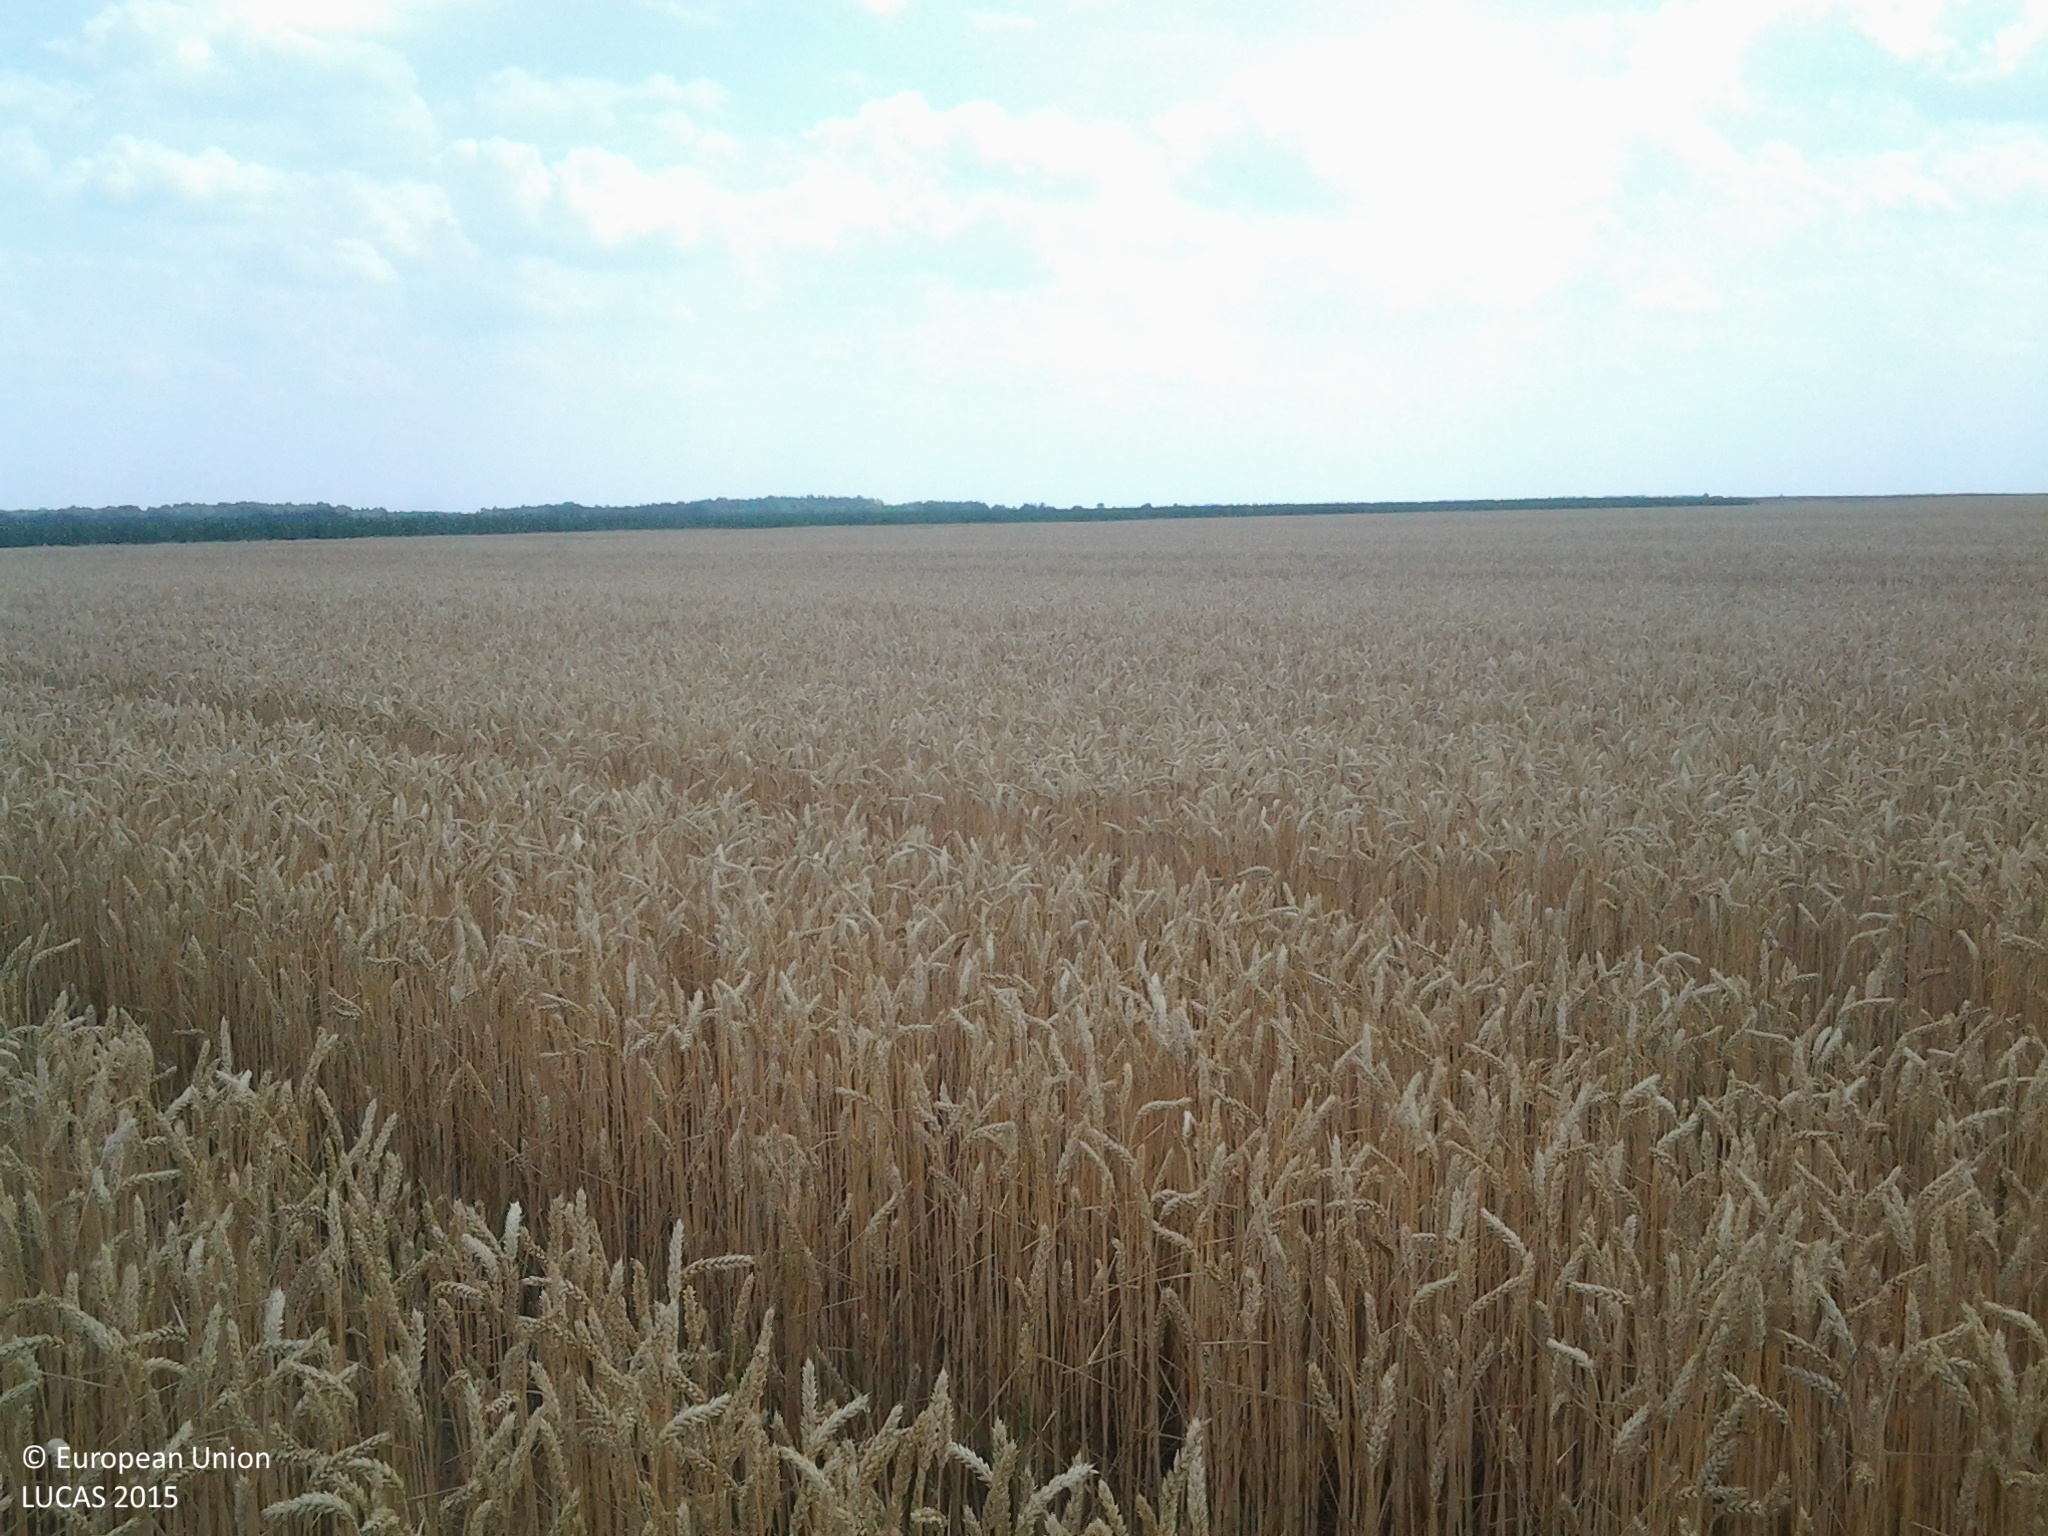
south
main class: Cropland
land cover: Common wheat
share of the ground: > 75 %
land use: Agriculture (excluding fallow land and kitchen gardens)
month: July
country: HU
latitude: 47.0933
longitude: 19.2263
